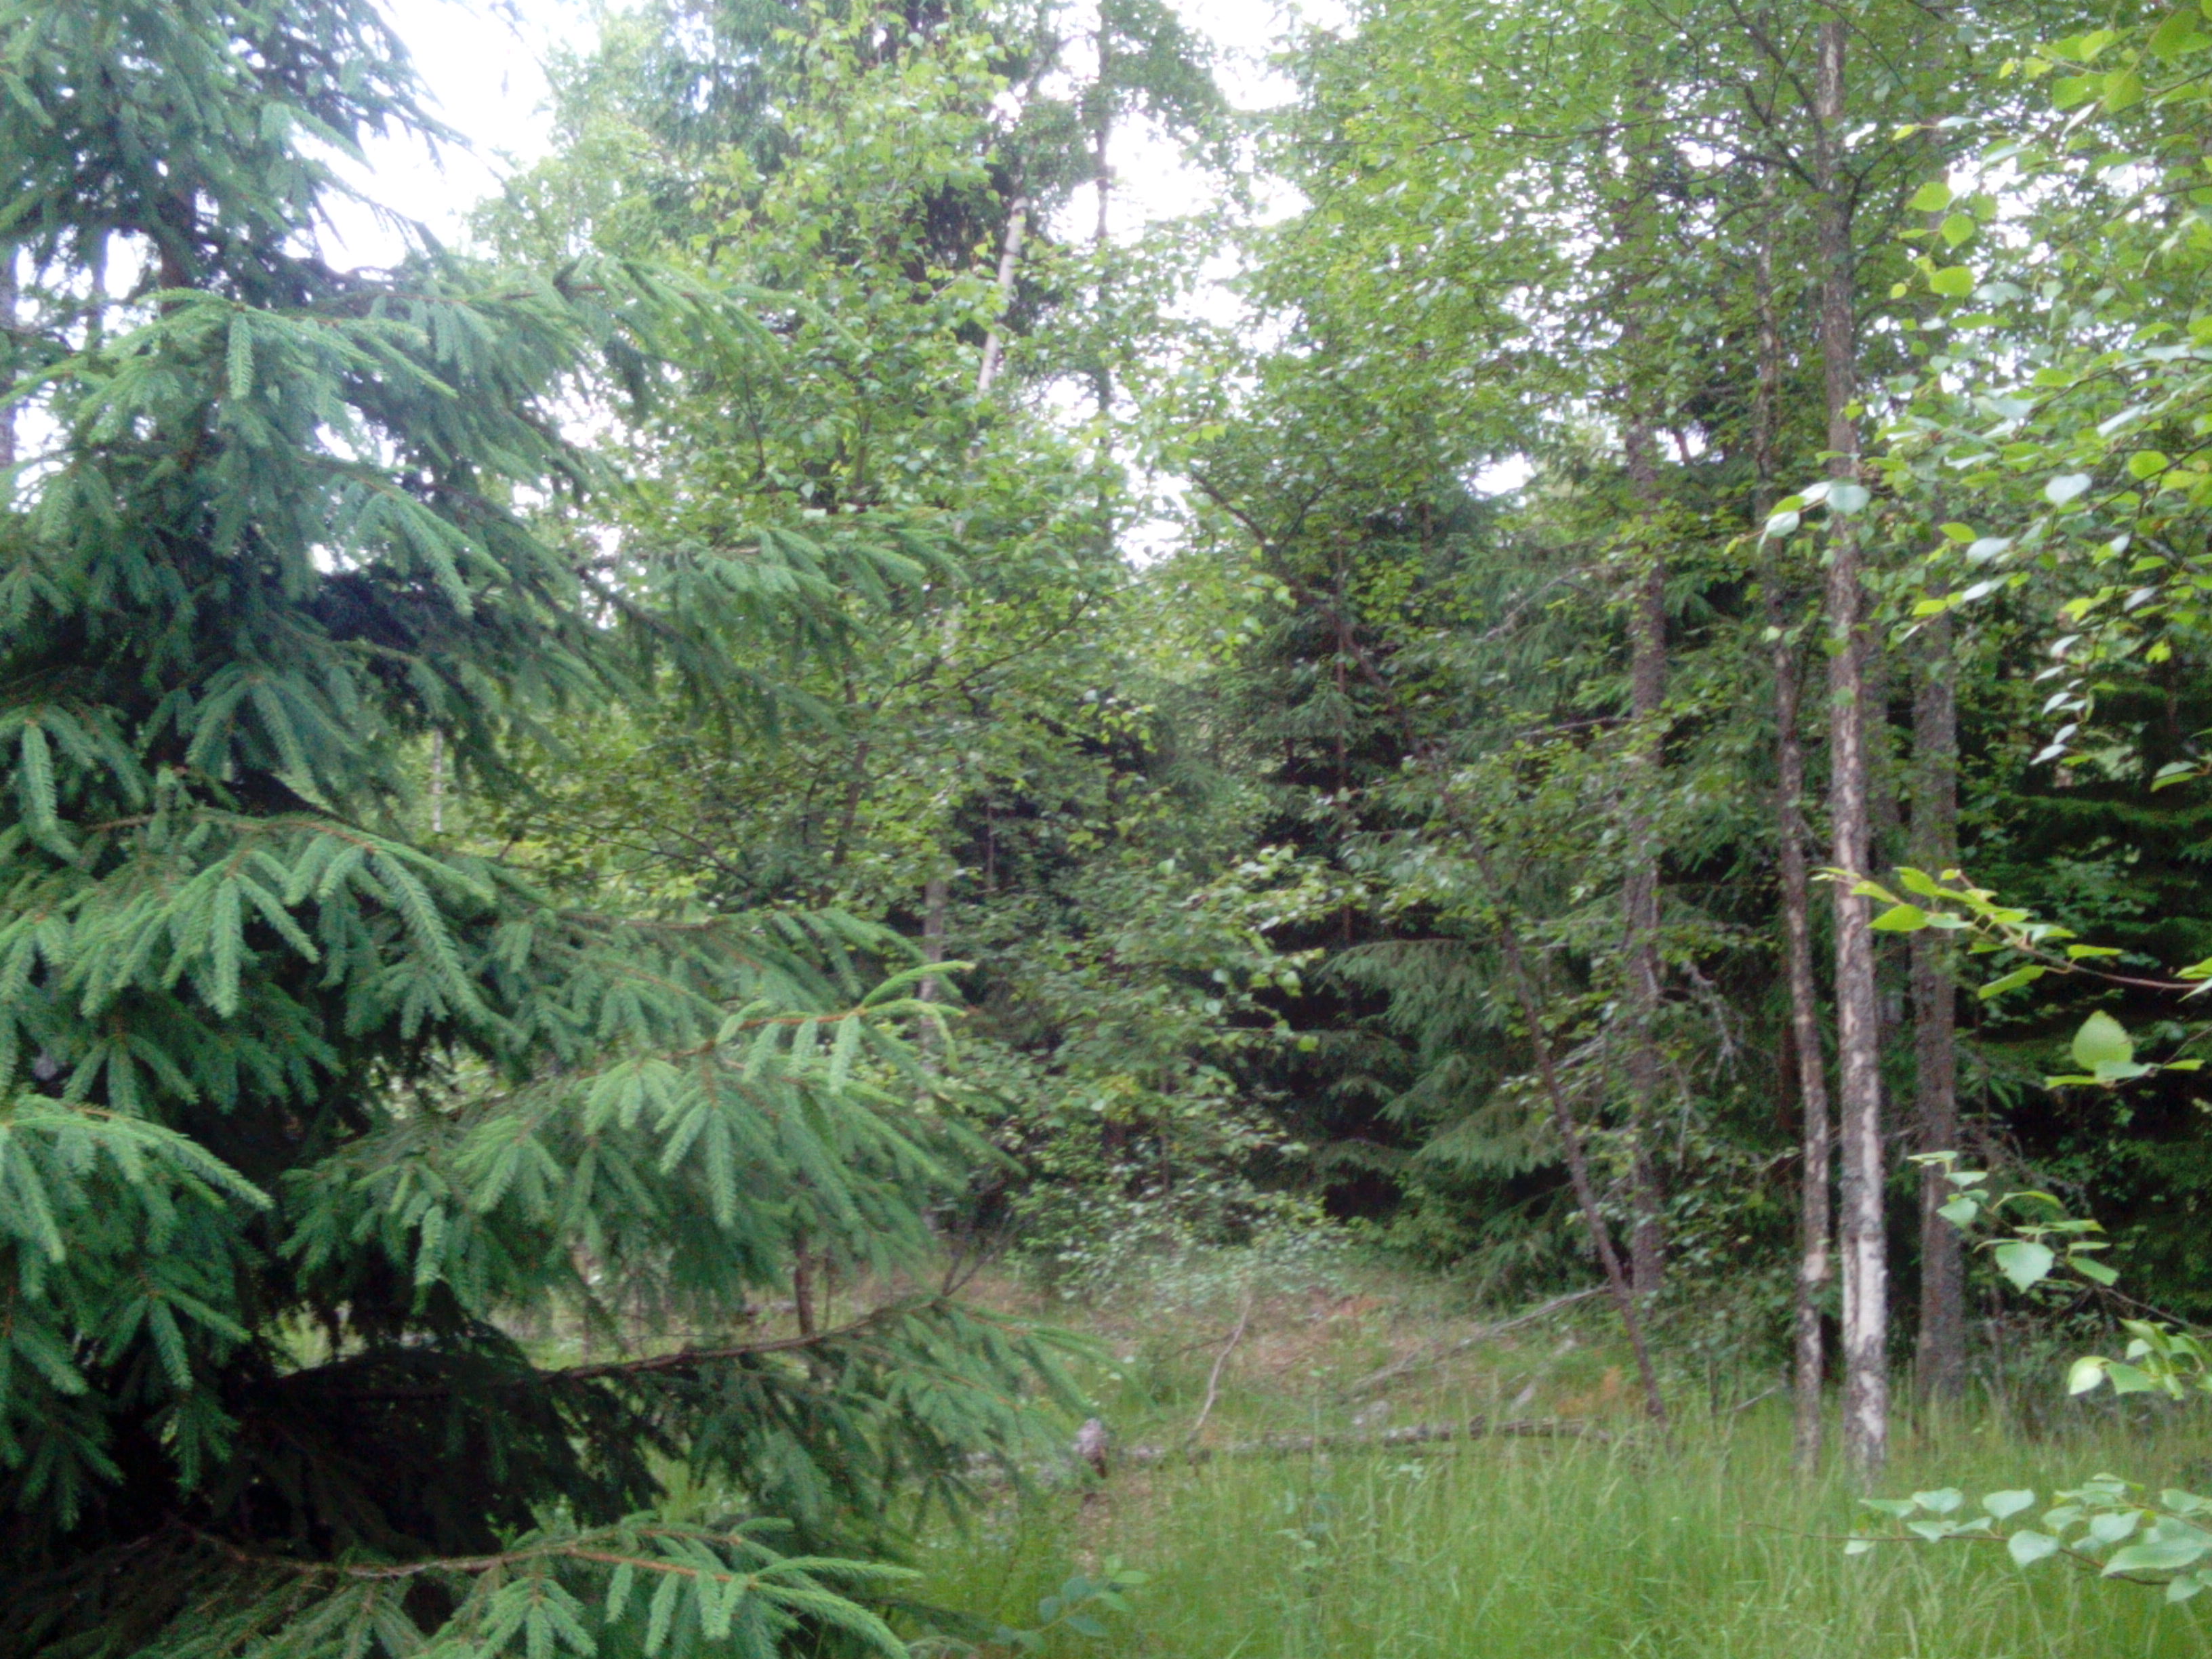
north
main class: Woodland
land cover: Spruce dominated mixed woodland
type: hemiboreal forest and nemoral coniferous forest and mixed broadleaved-coniferous forest
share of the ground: 50 - 75 %
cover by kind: broadleaved forest trees 45 %, coniferous forest trees 25 %, herbaceous plants 20 %, shrubs 10 %
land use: Forestry
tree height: > 5 m
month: June
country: LV
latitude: 56.9774
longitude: 21.5080
